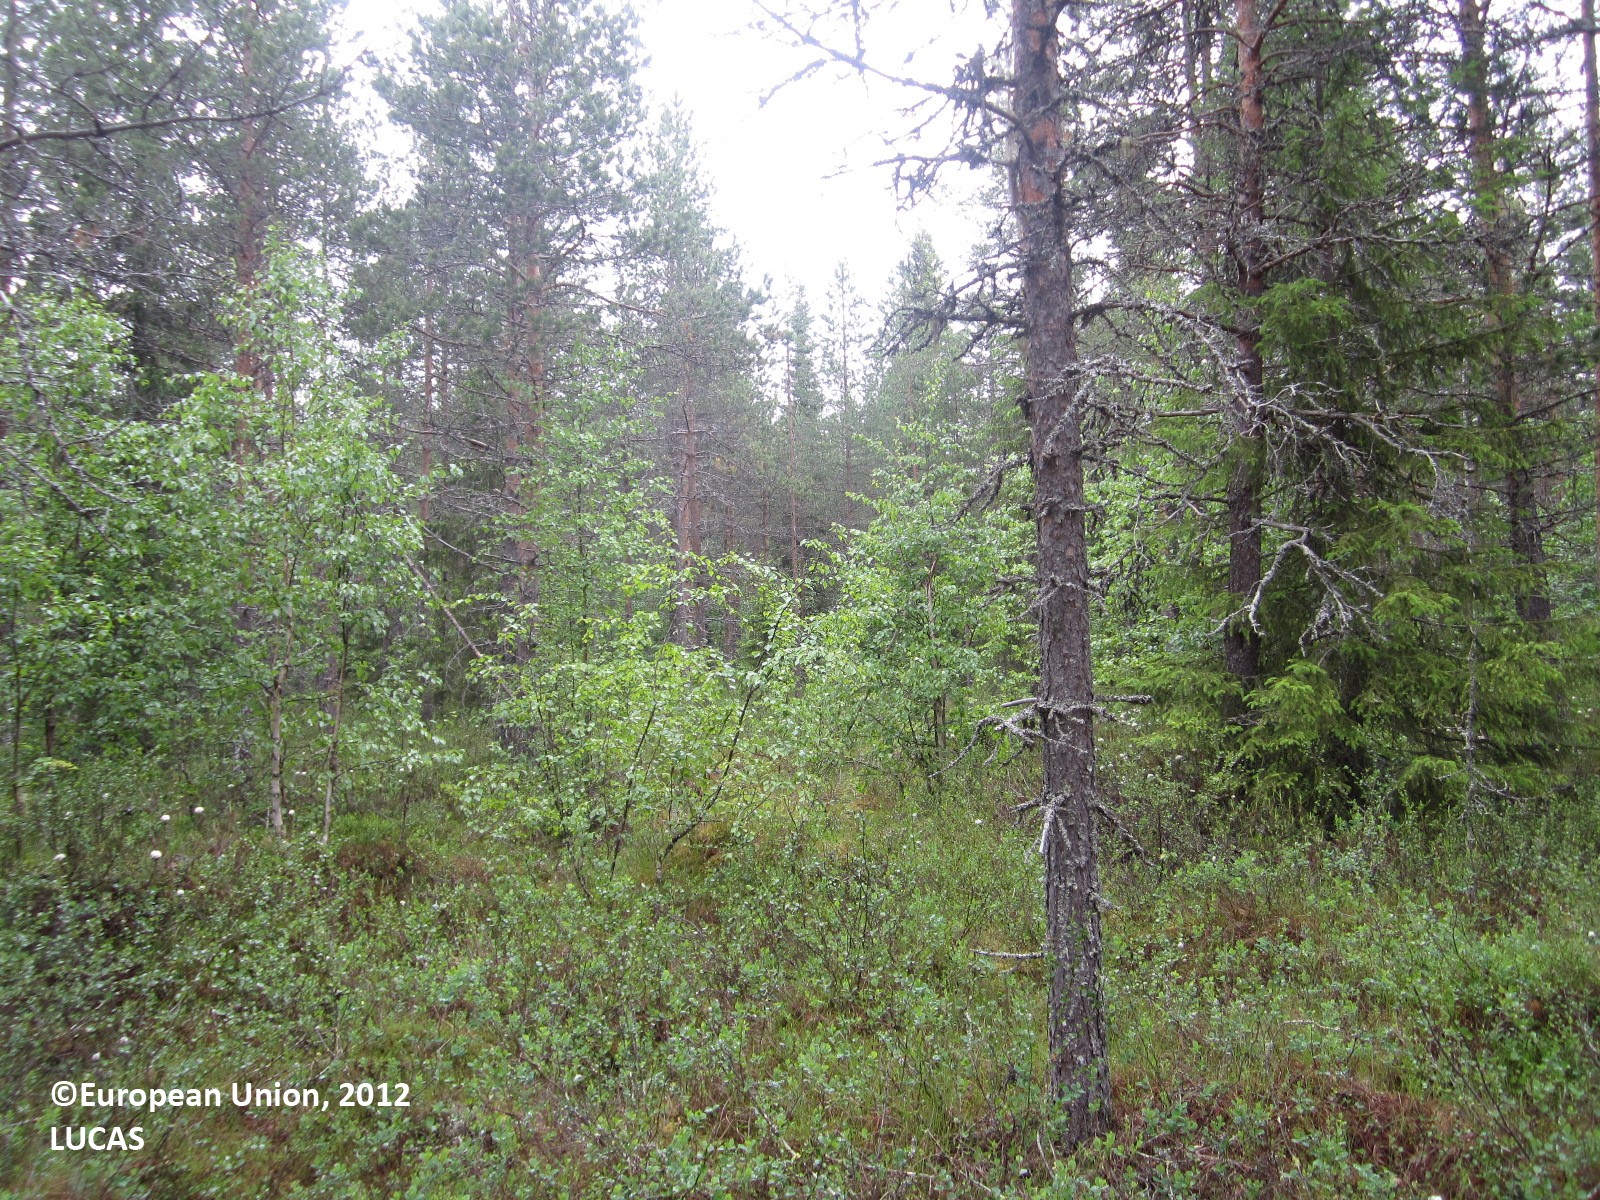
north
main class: Woodland
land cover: Pine dominated coniferous woodland
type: boreal forest
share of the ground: 50 - 75 %
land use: Forestry
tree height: > 5 m
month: June
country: FI
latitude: 64.4410
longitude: 29.2109
